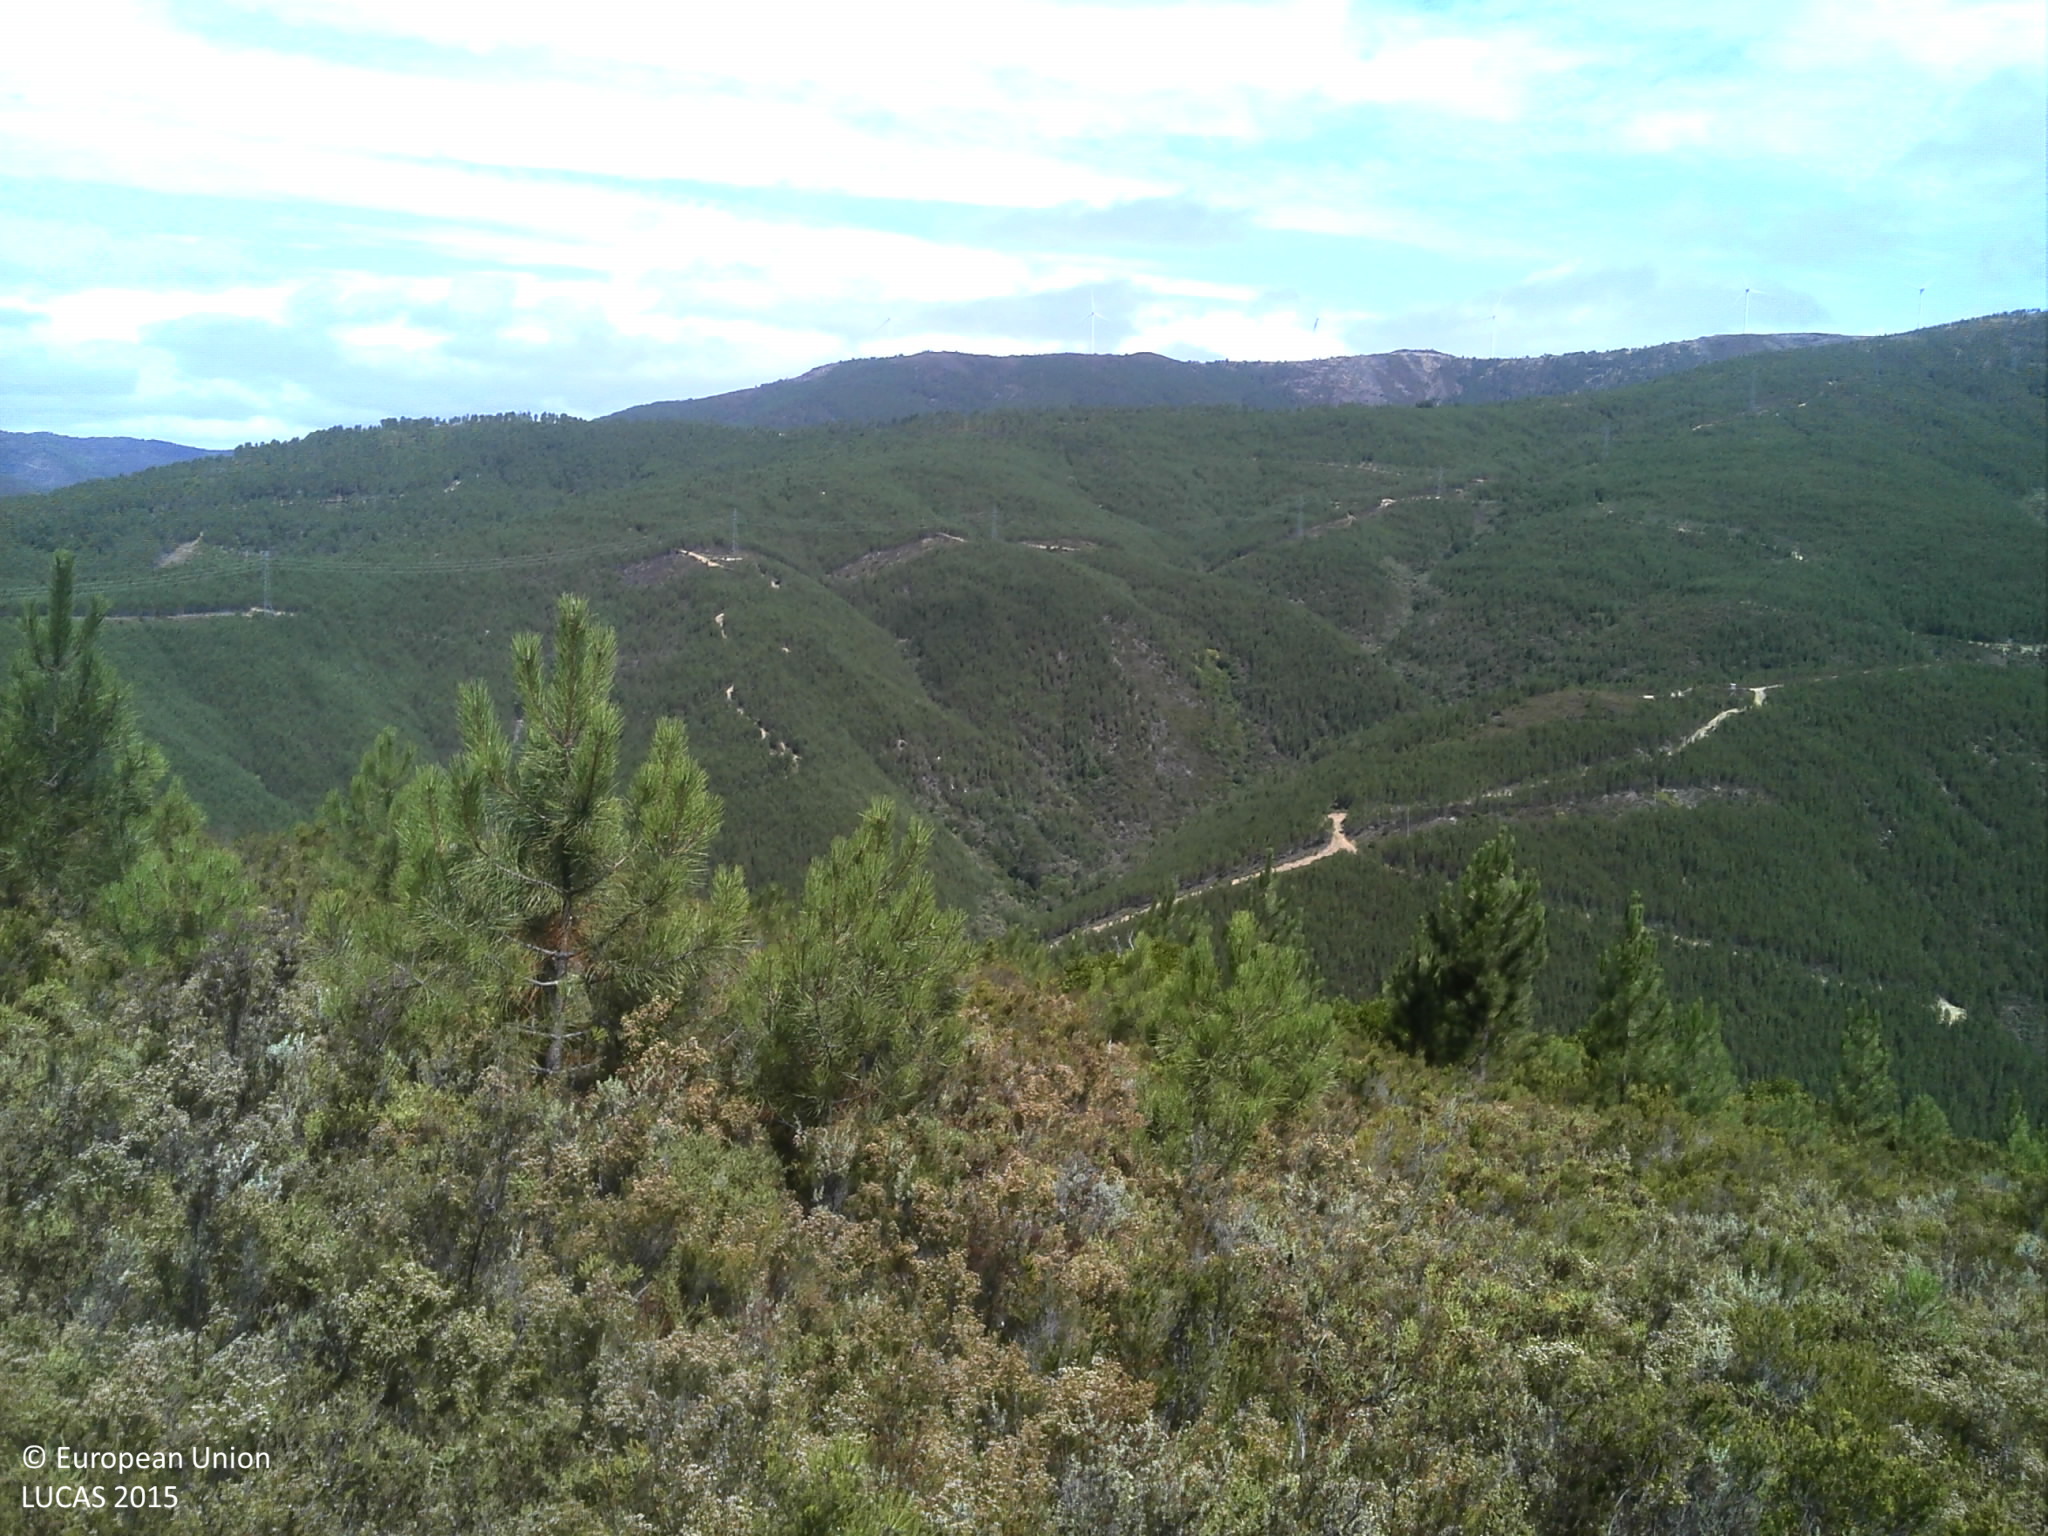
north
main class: Shrubland
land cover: Shrubland without tree cover
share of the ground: > 75 %
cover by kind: shrubs 90 %, unconsolidated bare surface 10 %
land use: Semi-natural and natural areas not in use
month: July
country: PT
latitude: 40.1575
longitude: -7.9018
